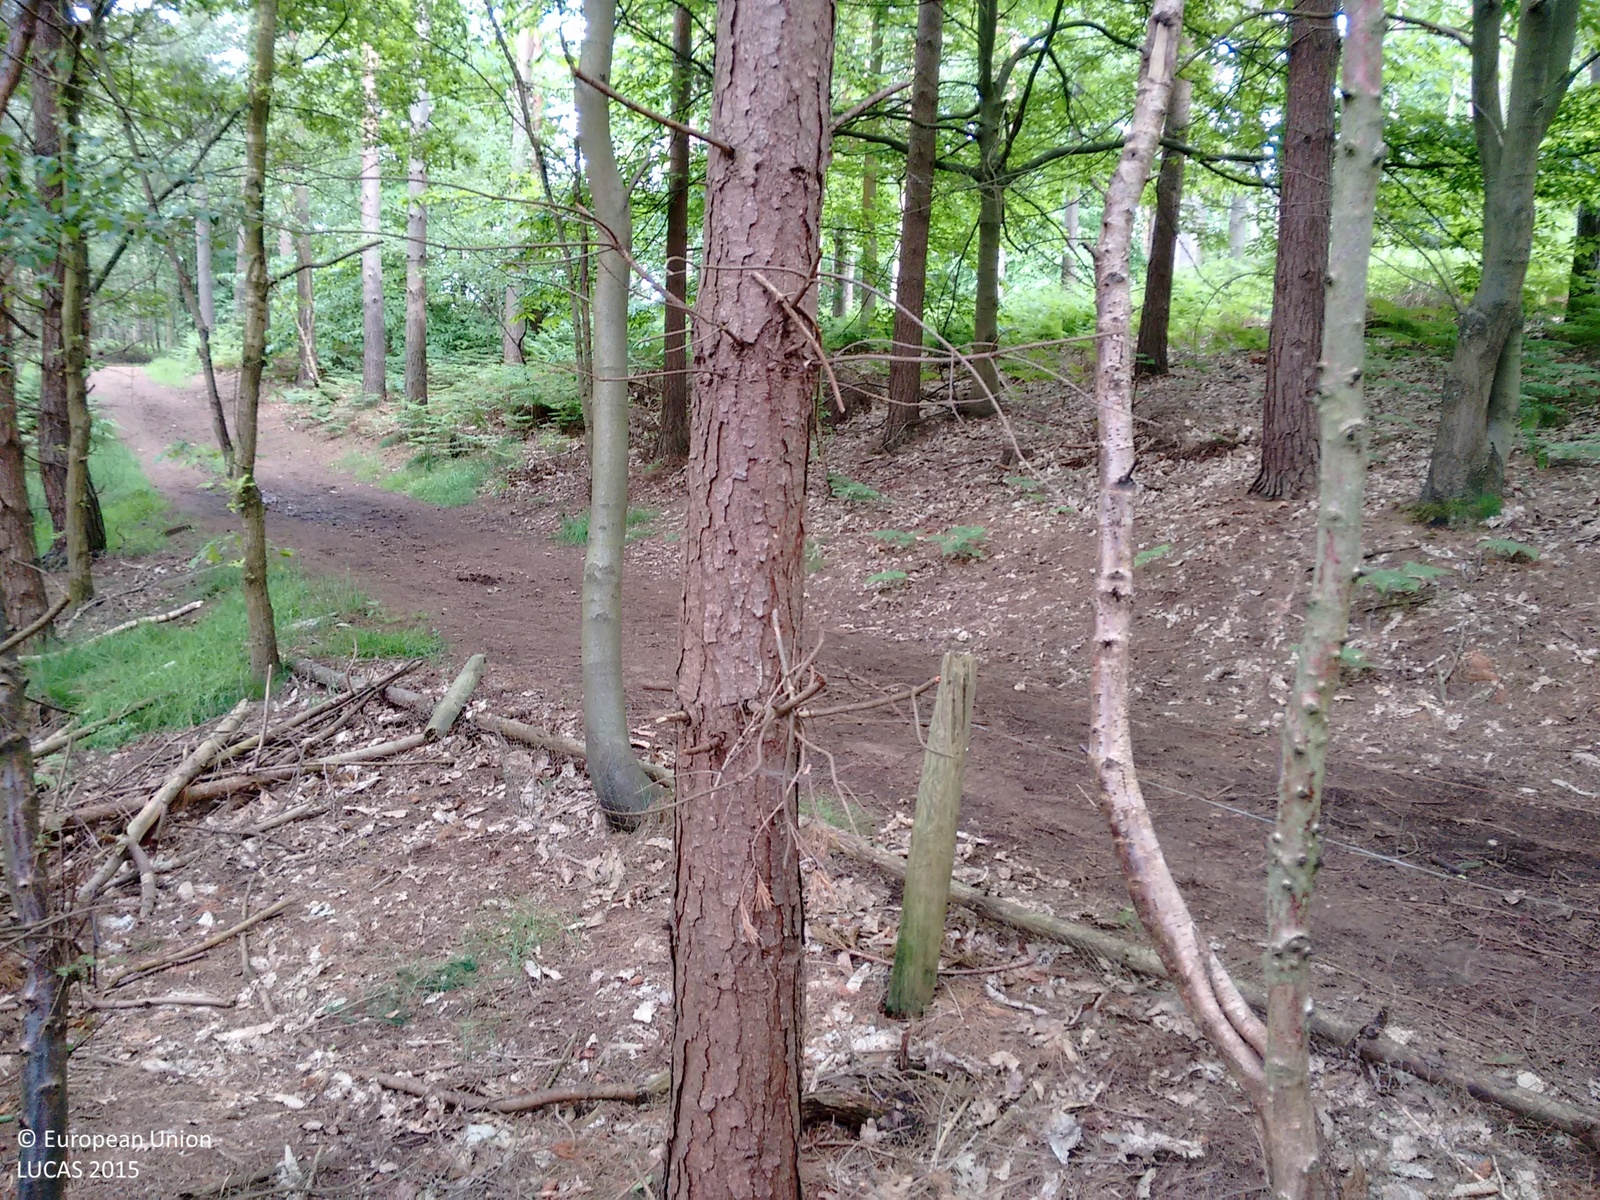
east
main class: Woodland
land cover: Pine dominated coniferous woodland
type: exotic forest
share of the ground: > 75 %
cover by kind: coniferous forest trees 90 %, broadleaved forest trees 10 %
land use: Forestry
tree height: > 5 m
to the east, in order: Pine dominated coniferous woodland; Fences; Tracks; Pine dominated mixed woodland; Tracks; Pine dominated mixed woodland; Tracks; Broadleaved woodland; Fences; Broadleaved woodland
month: June
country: GB
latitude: 52.0049
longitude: -0.6598
